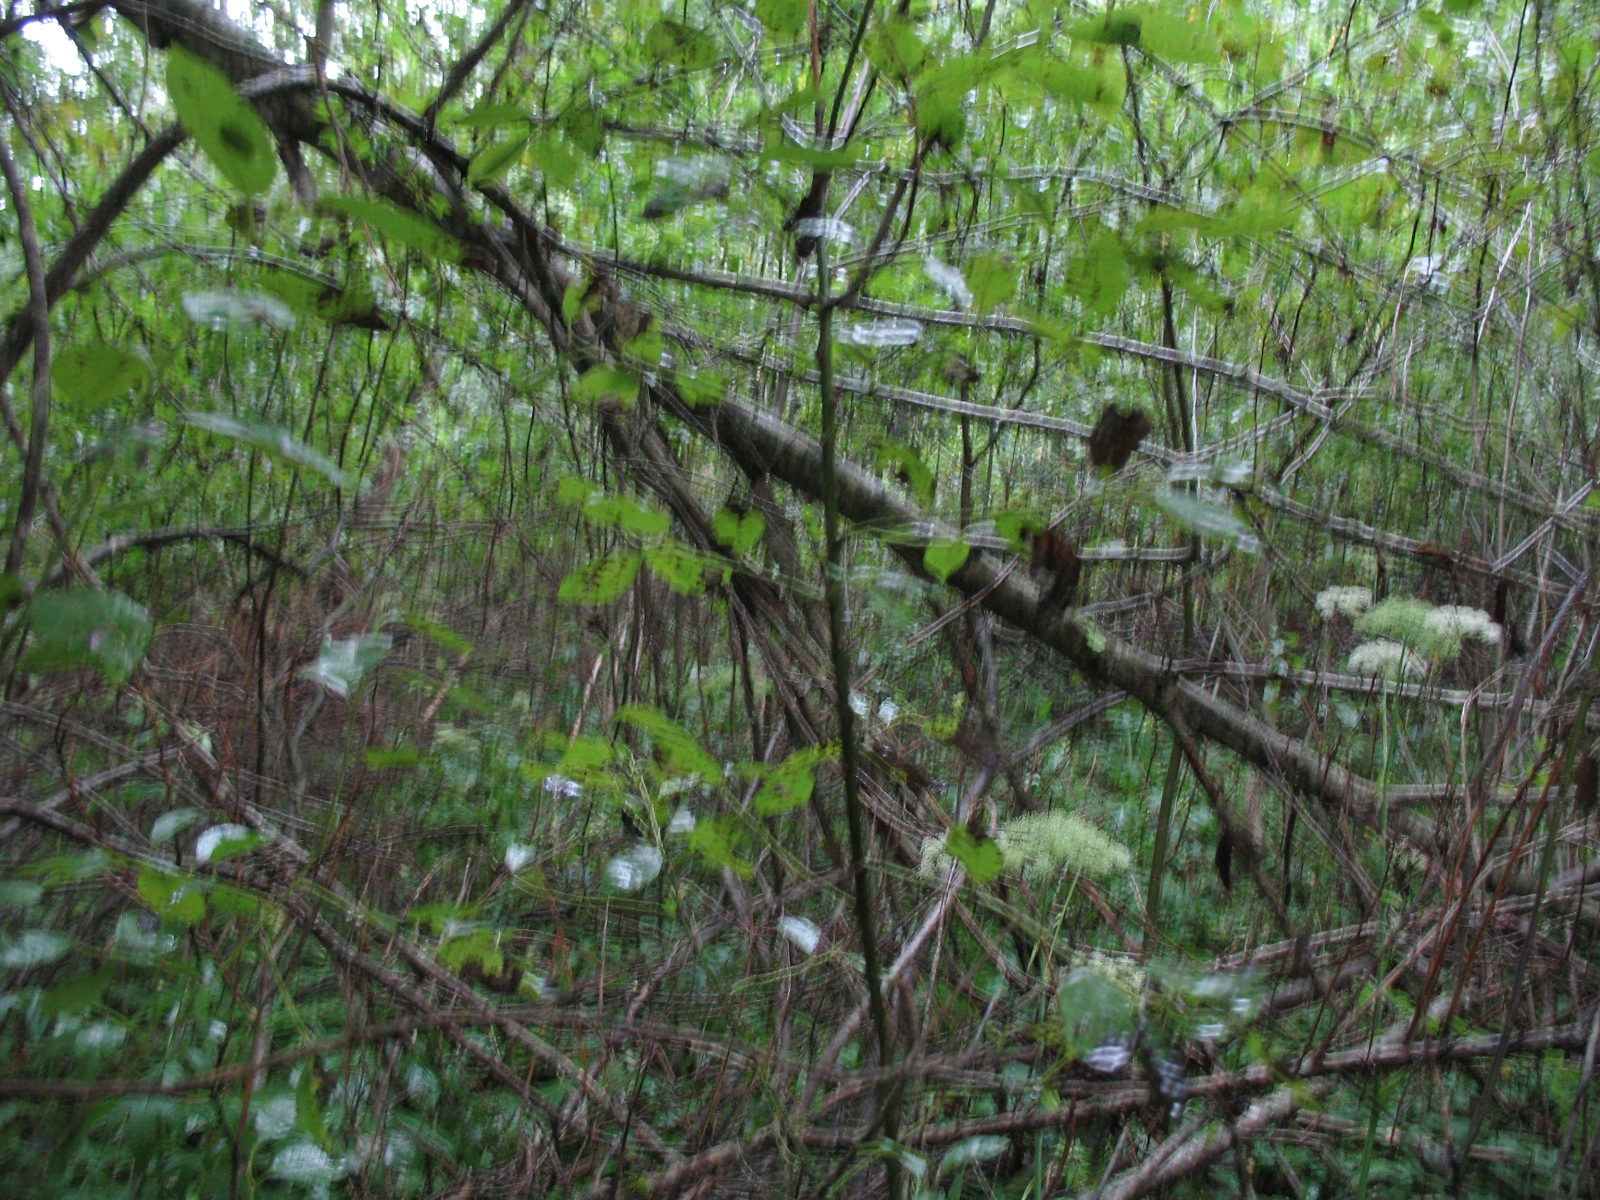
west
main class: Woodland
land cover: Broadleaved woodland
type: non-riverine alder, birch or aspen forest
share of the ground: > 75 %
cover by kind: broadleaved forest trees 80 %, shrubs 15 %, herbaceous plants 5 %
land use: Forestry
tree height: > 5 m
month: August
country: LV
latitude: 56.2833
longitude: 25.9471
